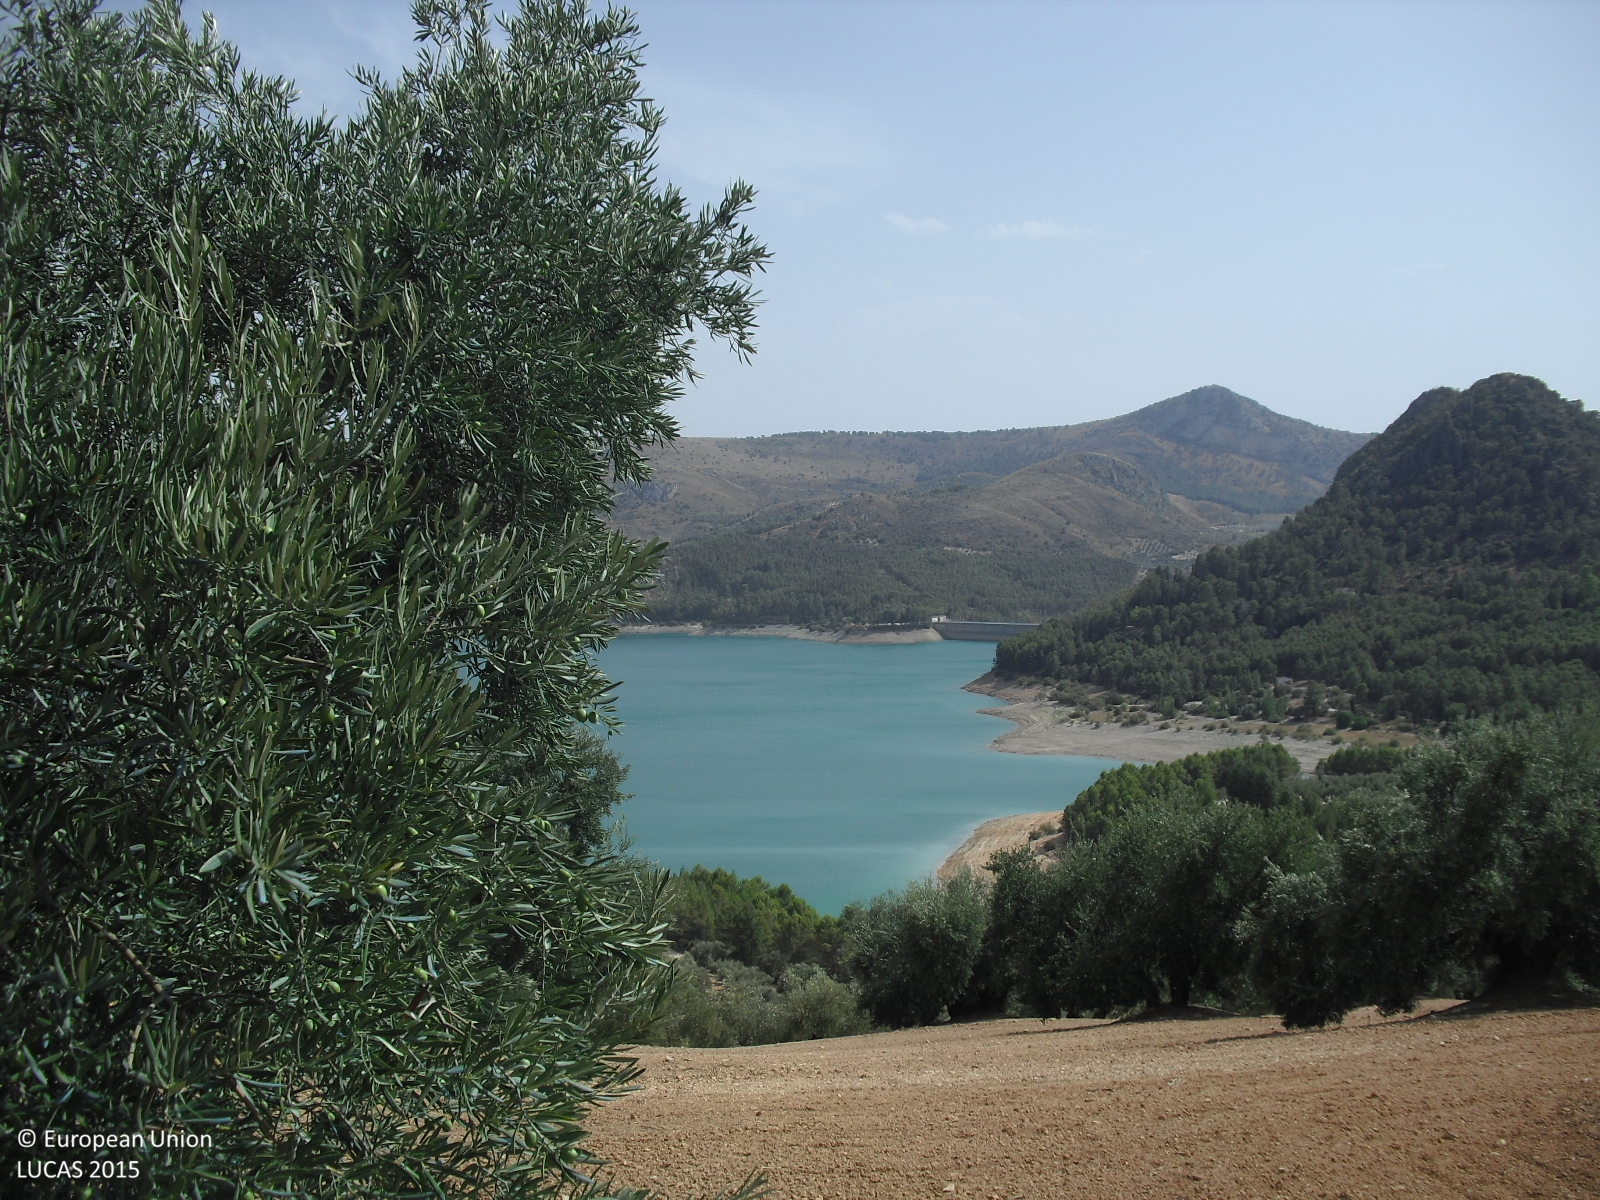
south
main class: Cropland
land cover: Olive groves
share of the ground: 25 - 50 %
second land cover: Other bare soil
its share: > 75 %
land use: Agriculture (excluding fallow land and kitchen gardens)
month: August
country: ES
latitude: 37.2917
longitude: -4.3817
